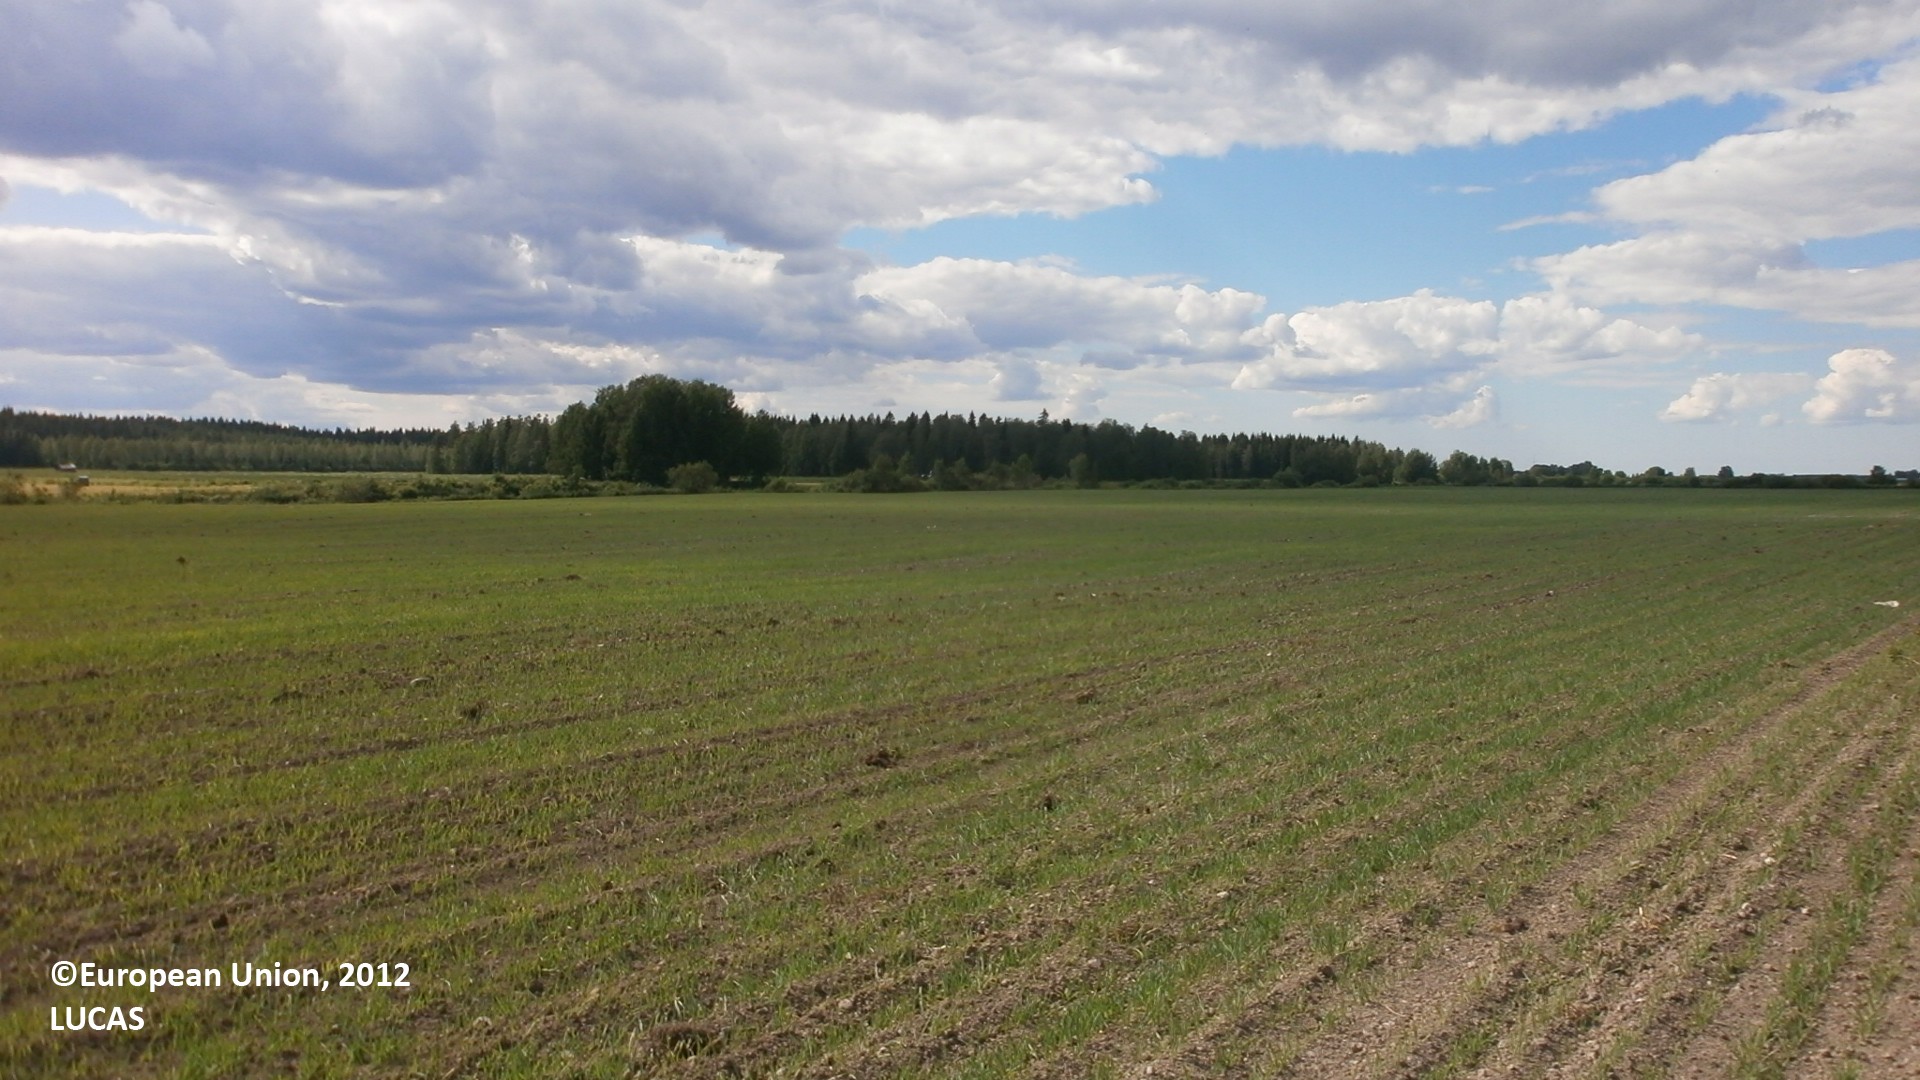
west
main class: Cropland
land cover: Oats
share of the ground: 10 - 25 %
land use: Agriculture (excluding fallow land and kitchen gardens)
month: July
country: FI
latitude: 64.0173
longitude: 24.7481
